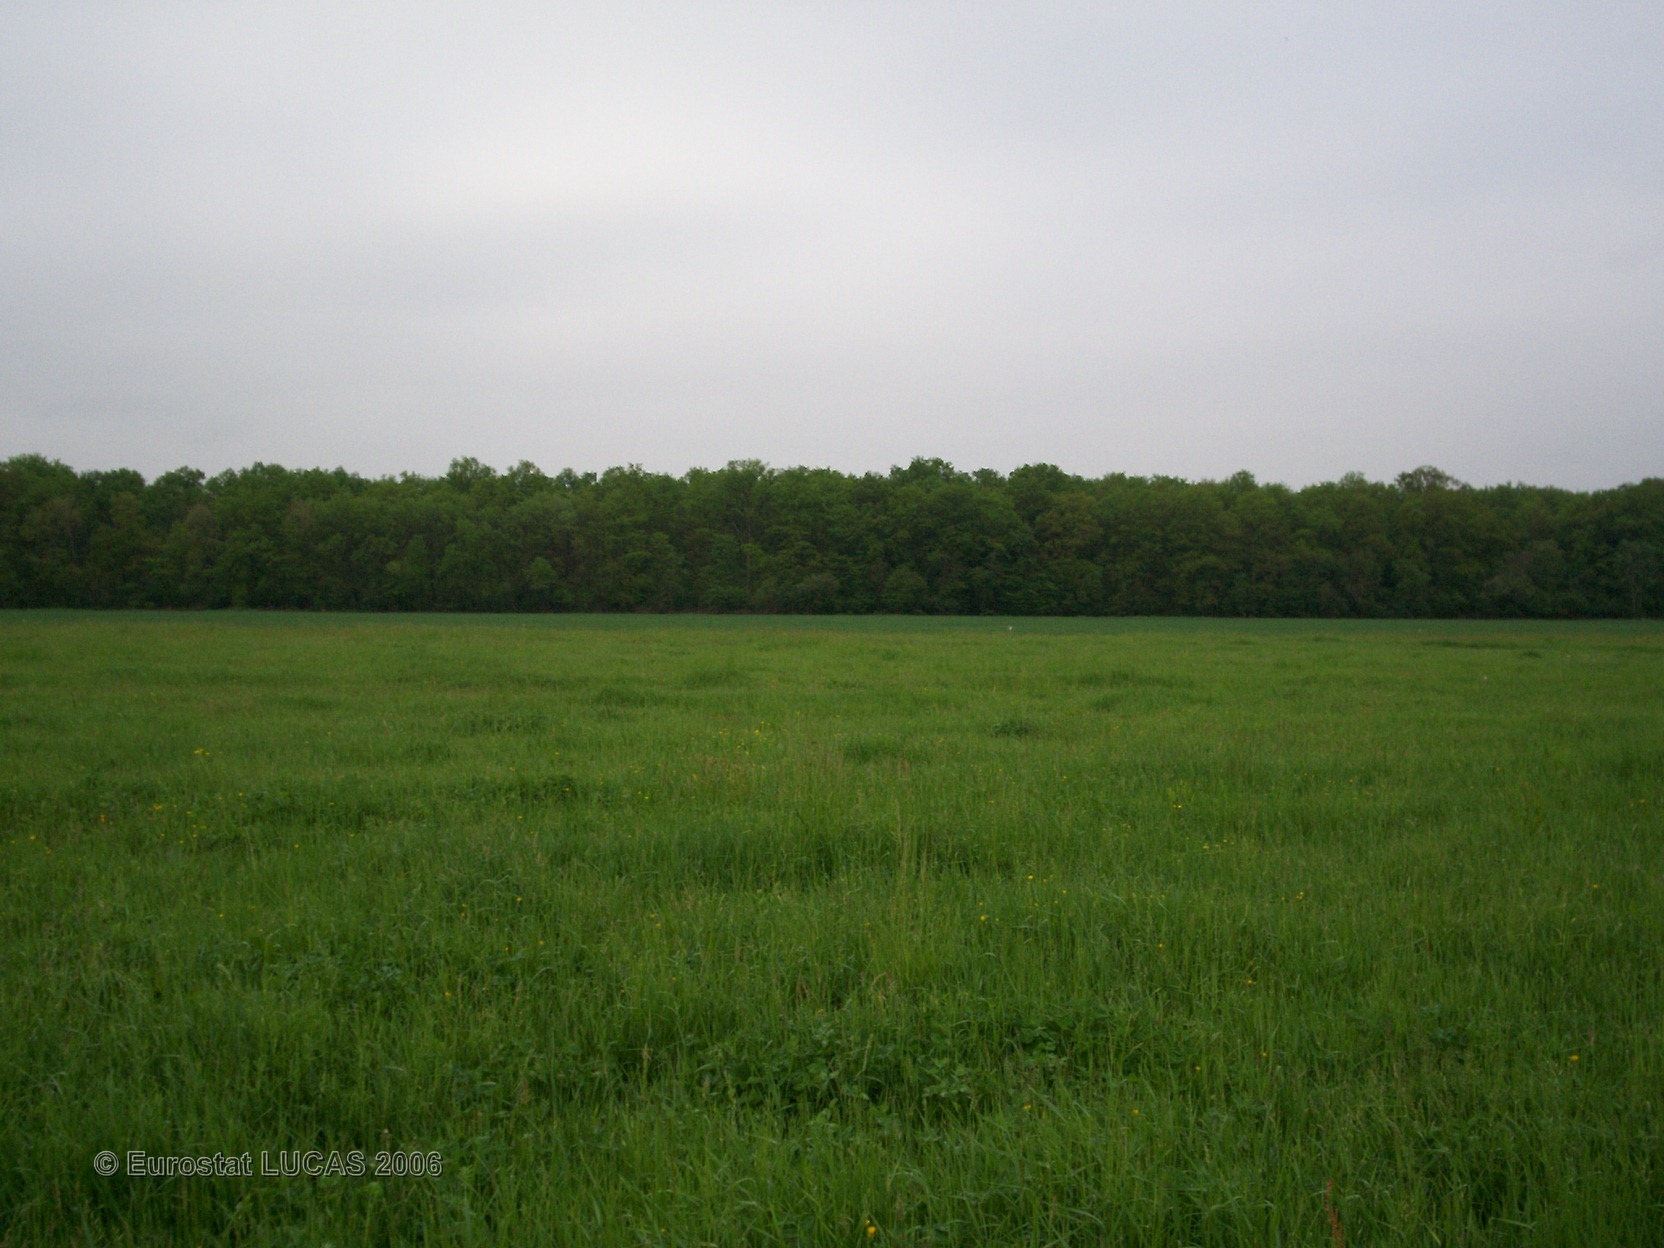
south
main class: Grassland
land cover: Grassland without tree/shrub cover
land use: Agriculture (excluding fallow land and kitchen gardens)
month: May
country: FR
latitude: 46.5431
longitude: 4.6679
